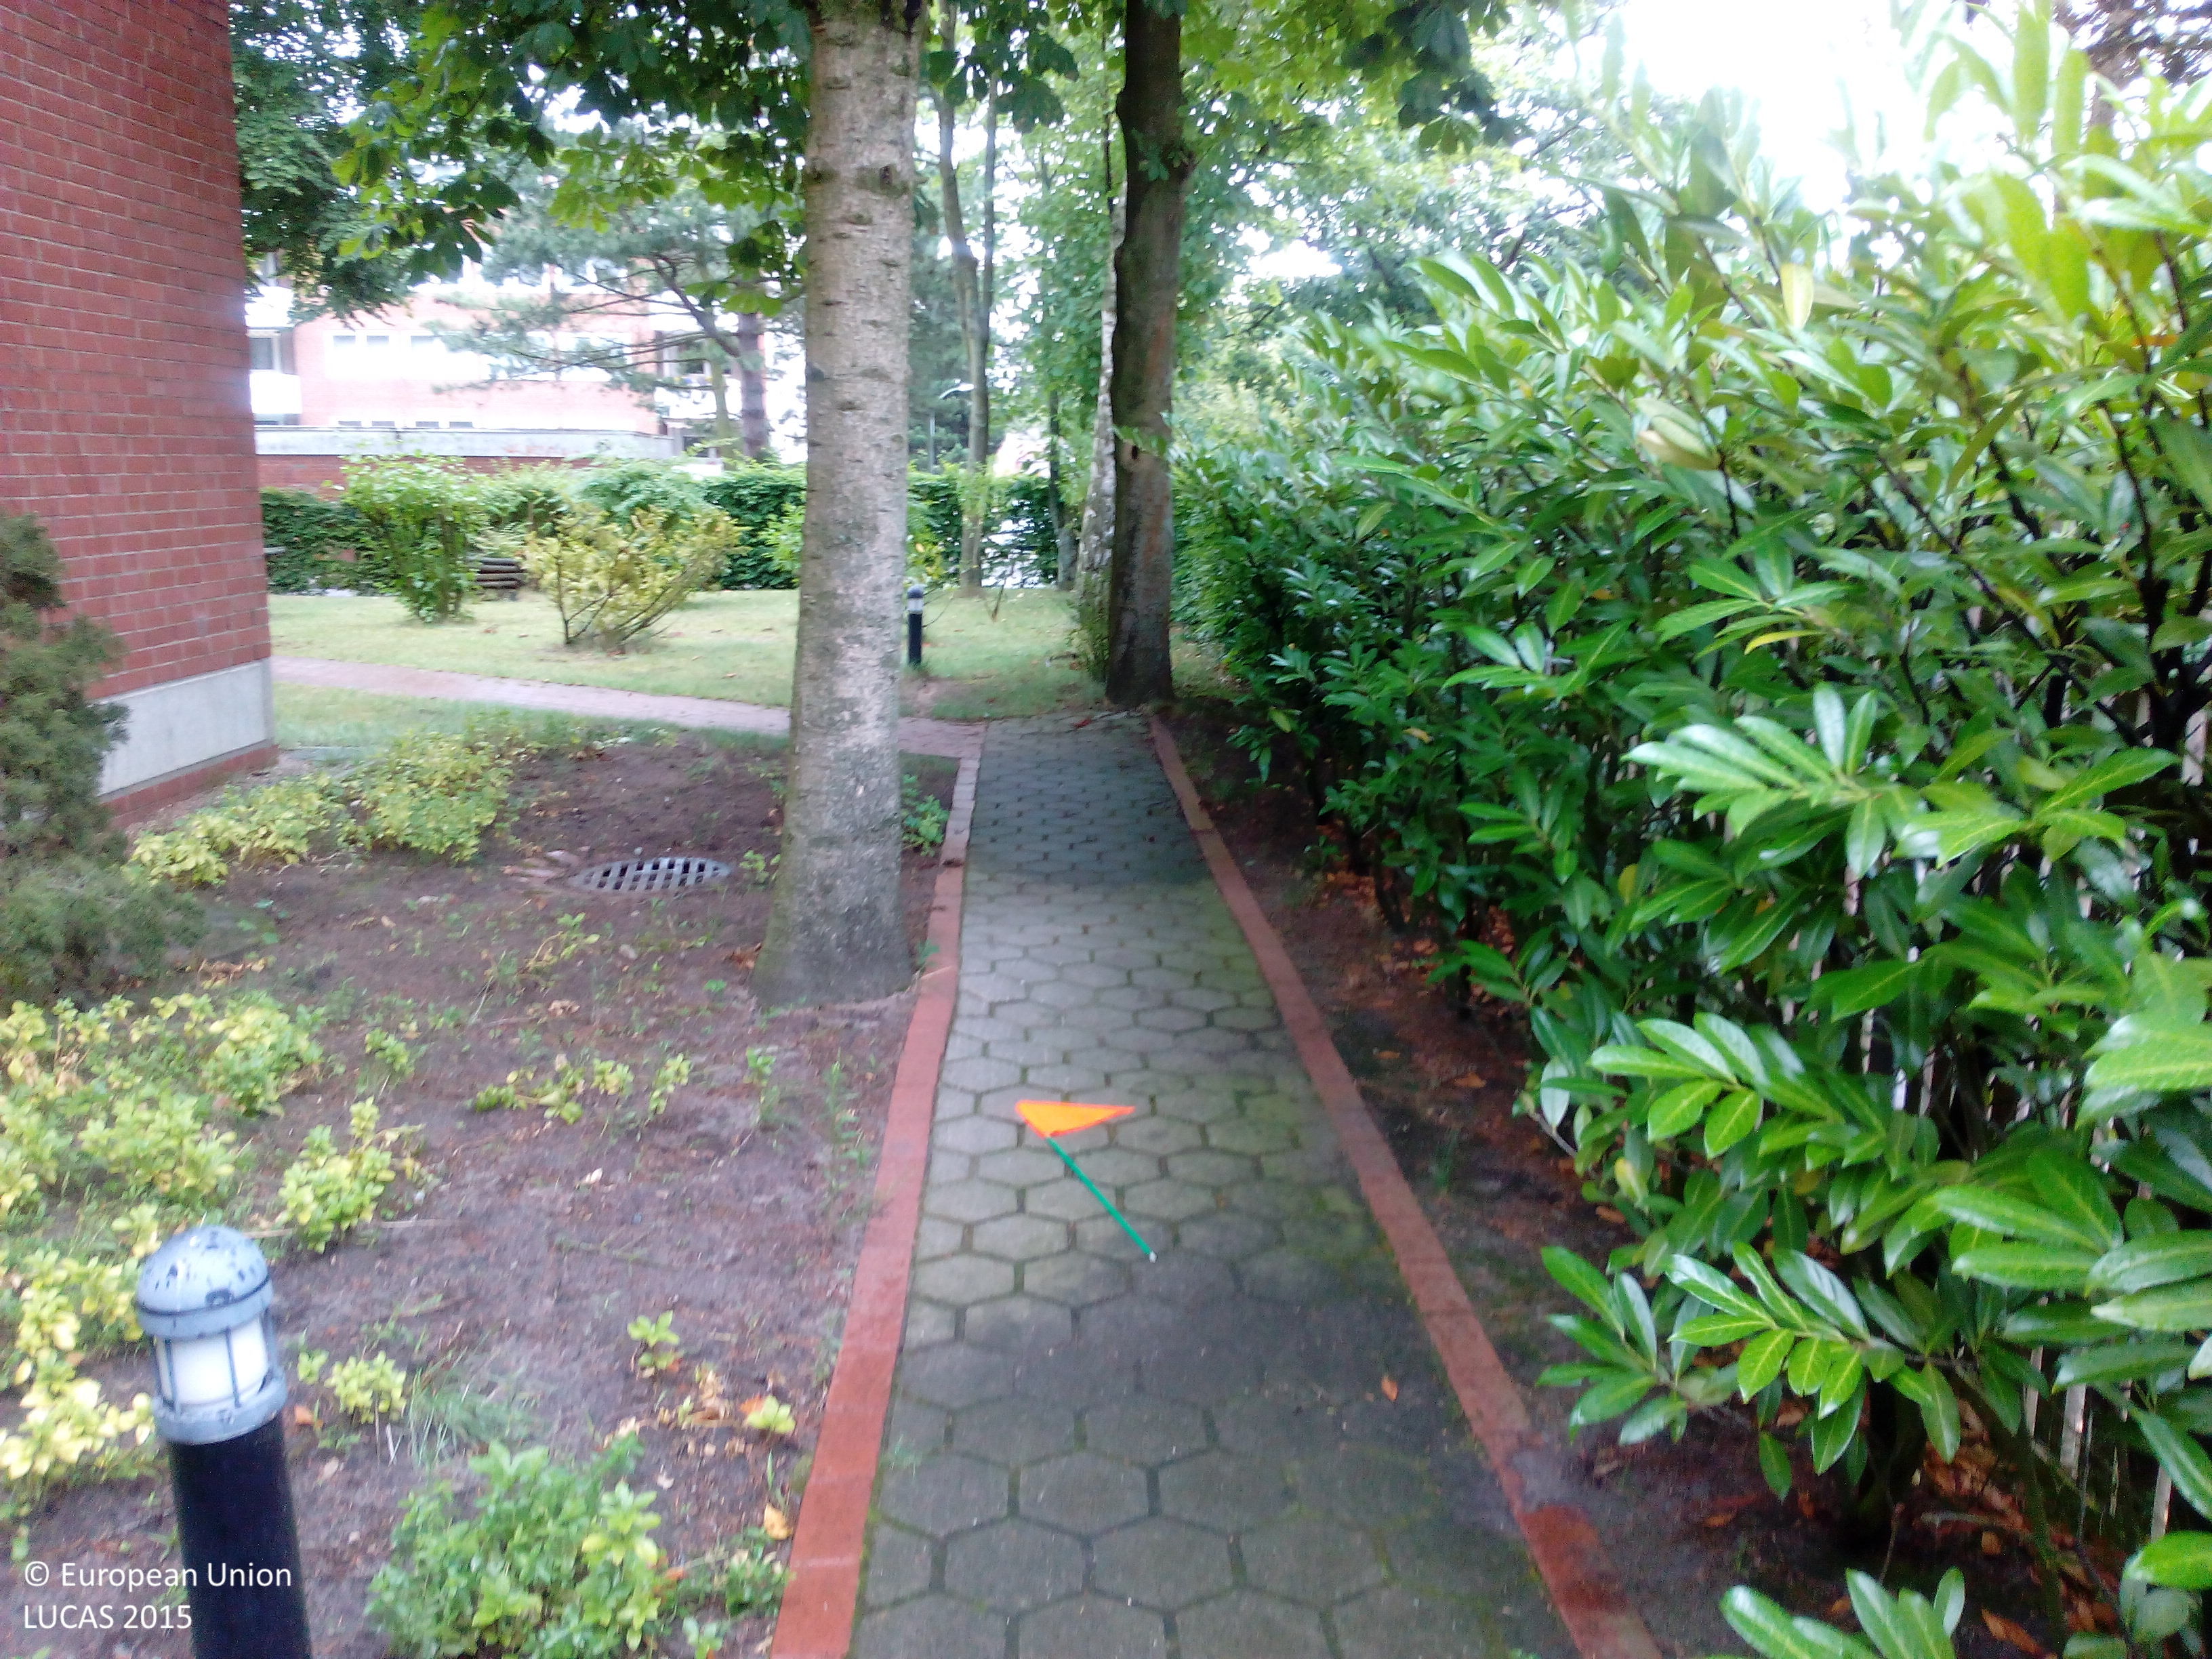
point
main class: Cropland
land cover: Floriculture and ornamental plants
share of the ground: 50 - 75 %
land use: Residential
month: July
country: DE
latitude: 52.2711
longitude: 8.0221
